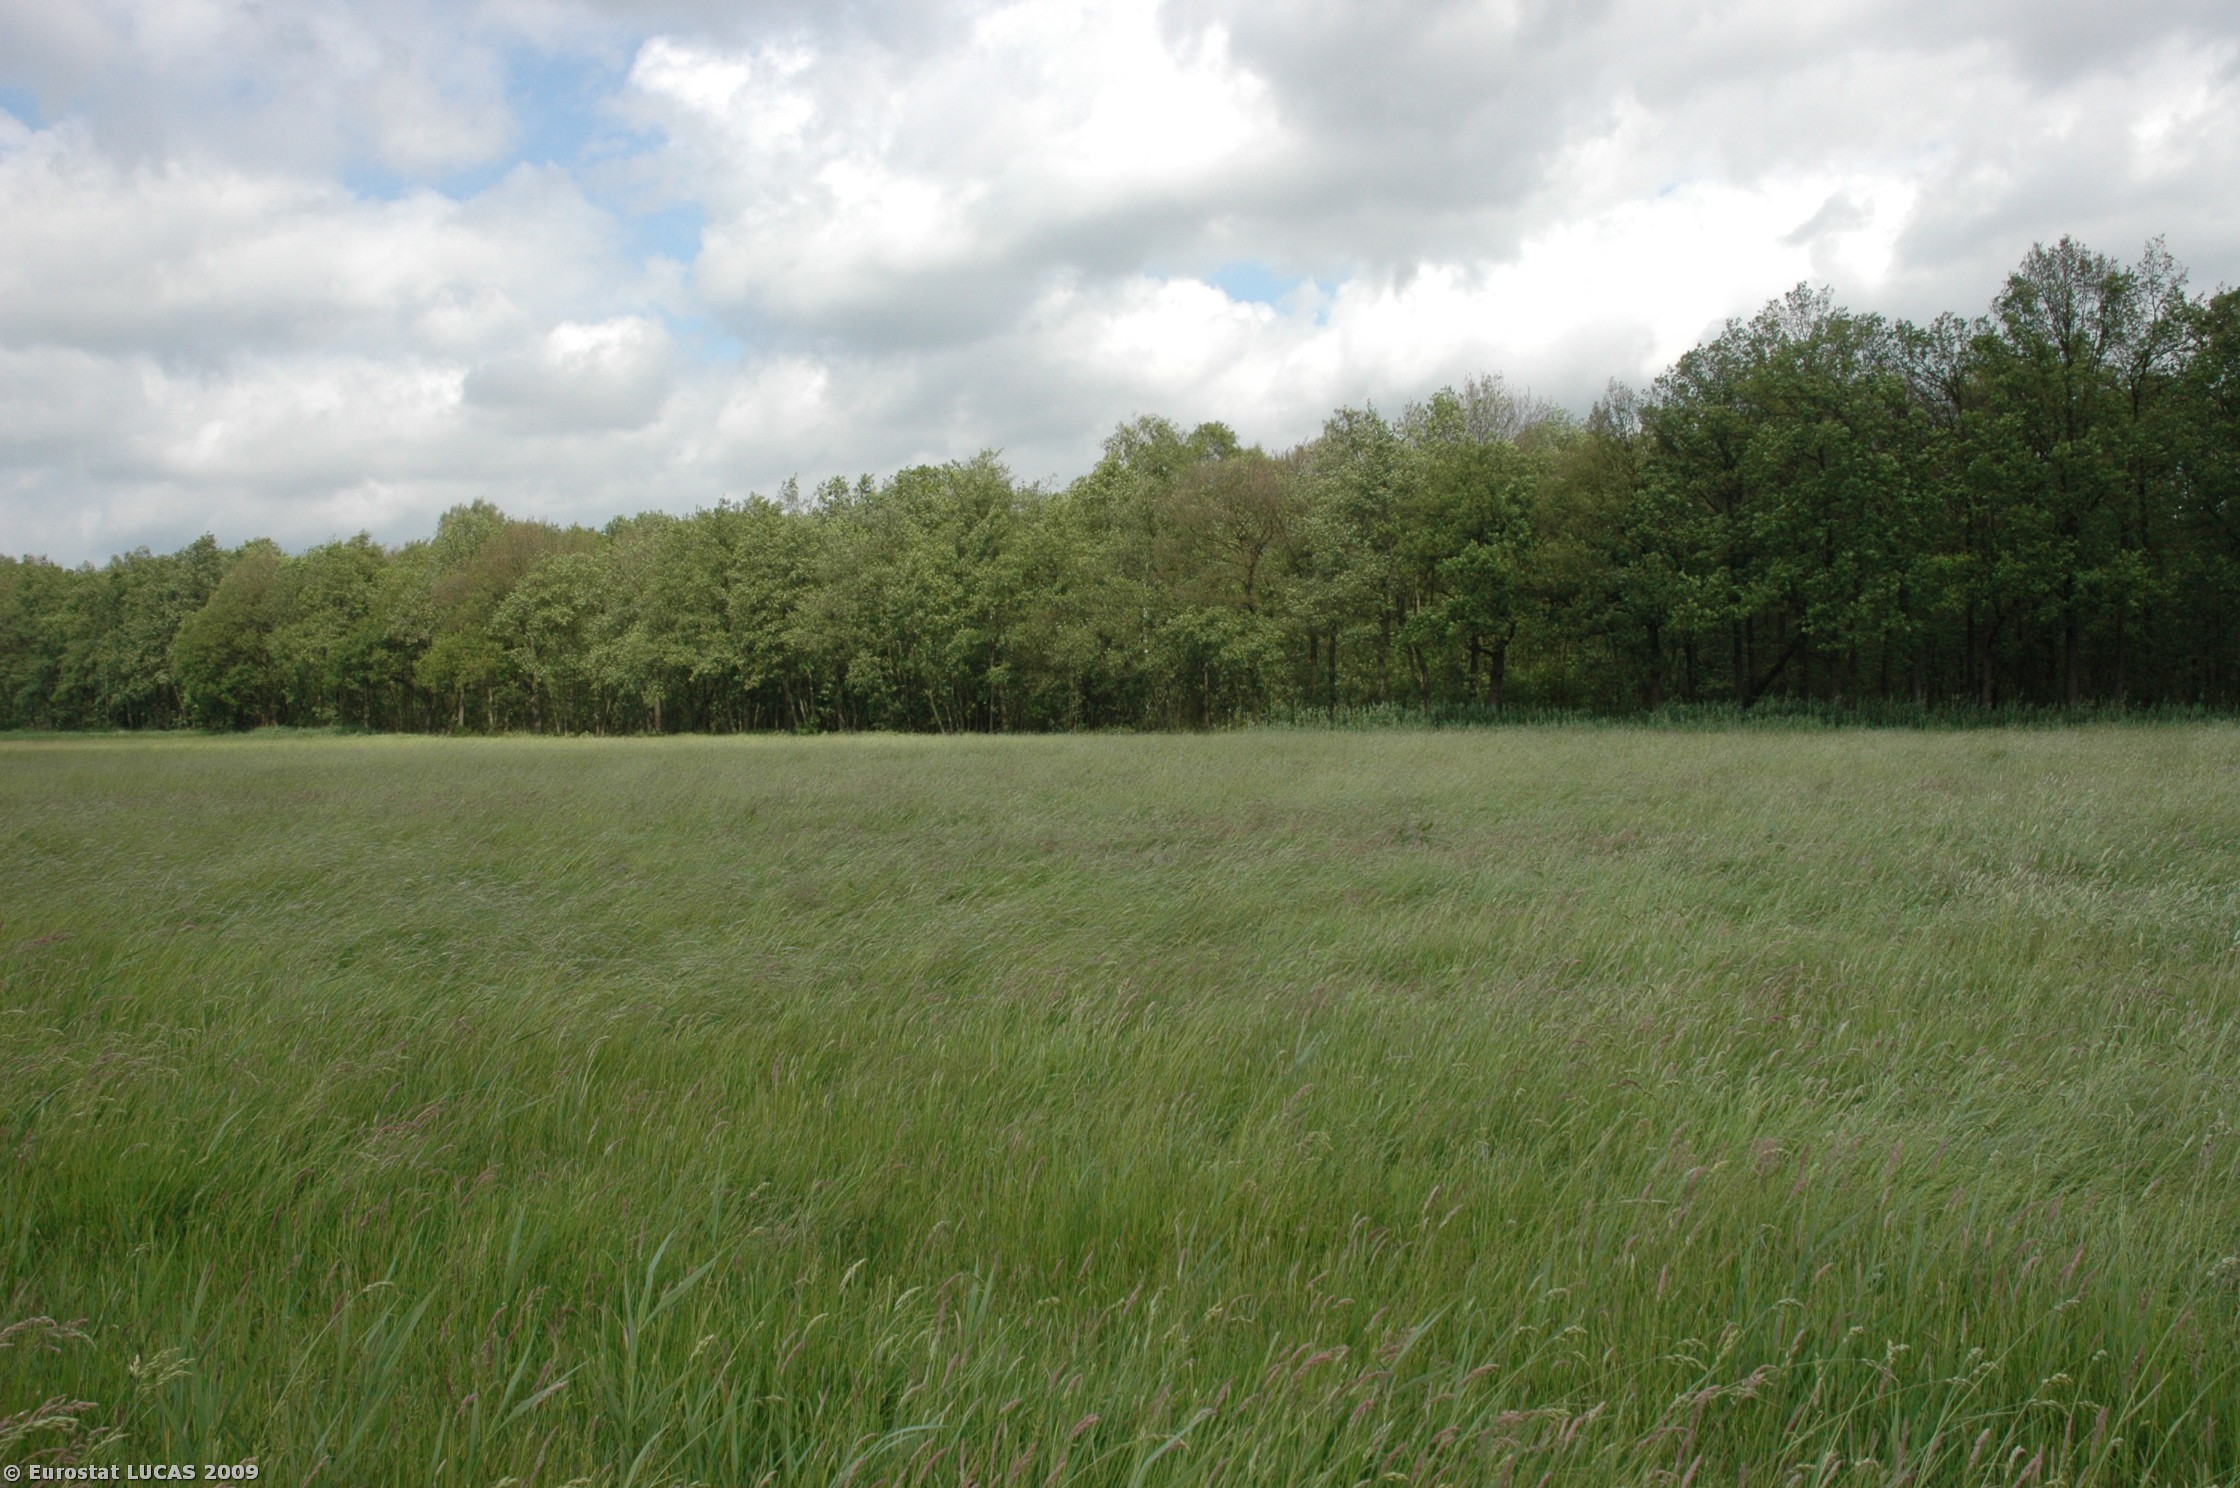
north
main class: Grassland
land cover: Grassland without tree/shrub cover
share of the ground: > 75 %
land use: Agriculture (excluding fallow land and kitchen gardens)
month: May
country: NL
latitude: 52.0796
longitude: 6.1032
